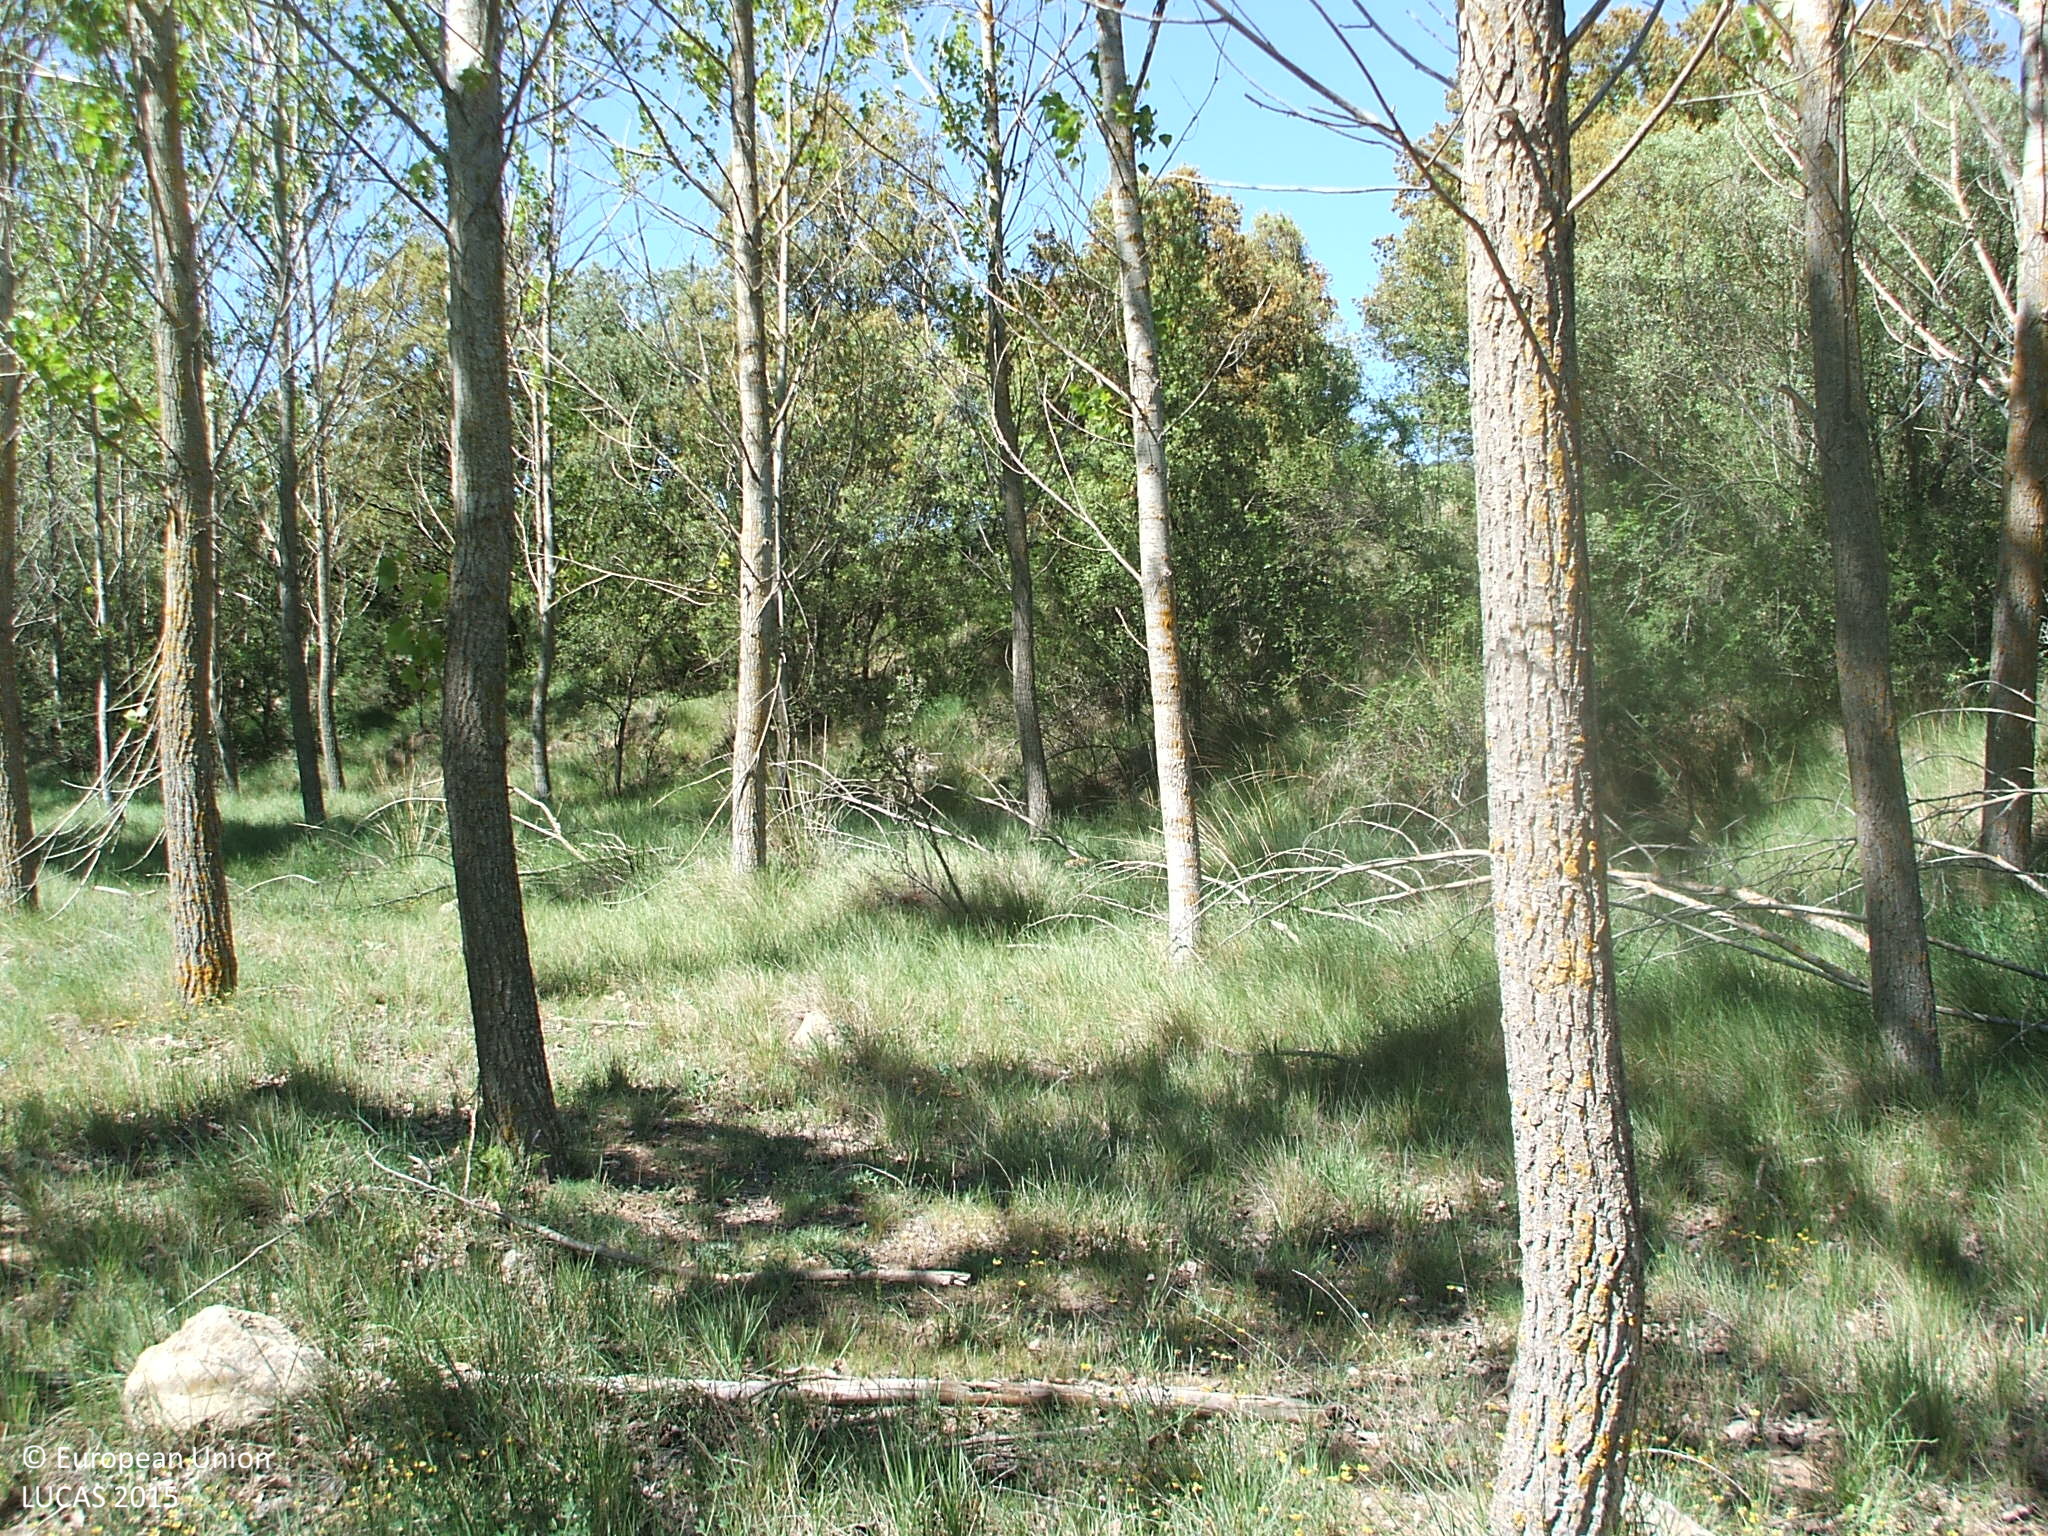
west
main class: Woodland
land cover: Broadleaved woodland
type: beech forest
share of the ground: > 75 %
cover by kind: broadleaved forest trees 100 %
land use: Semi-natural and natural areas not in use
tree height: > 5 m
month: May
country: ES
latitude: 40.0726
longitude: -0.7816
